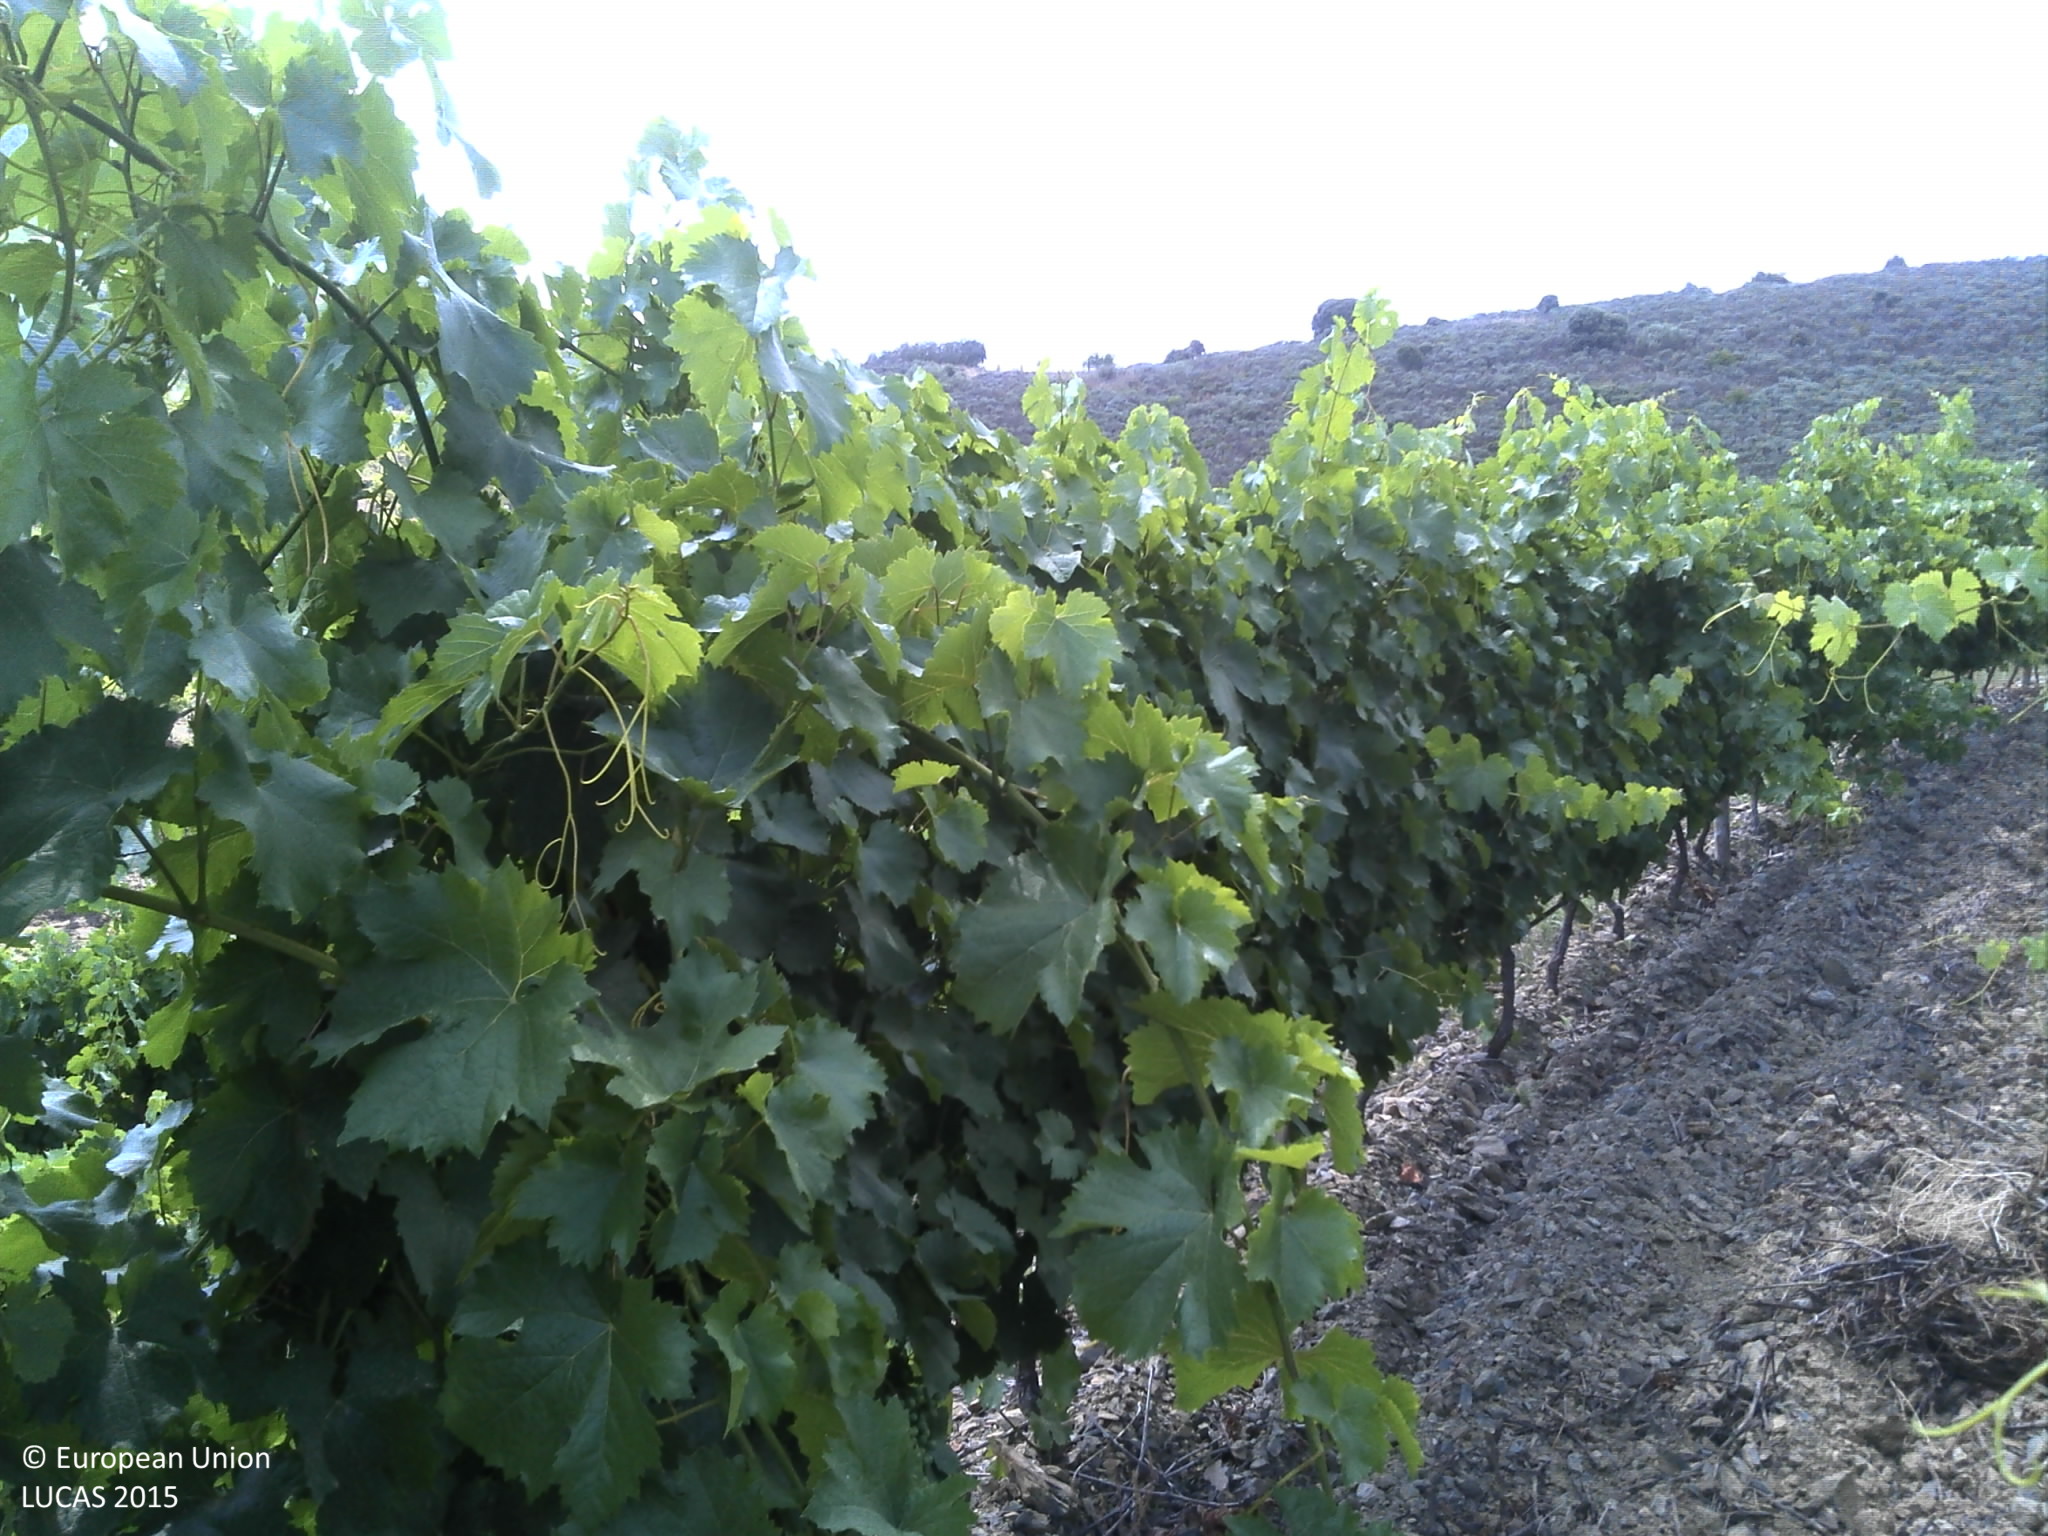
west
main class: Cropland
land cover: Vineyards
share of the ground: 10 - 25 %
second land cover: Other bare soil
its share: > 75 %
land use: Agriculture (excluding fallow land and kitchen gardens)
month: June
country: PT
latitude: 41.0690
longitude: -6.8245
